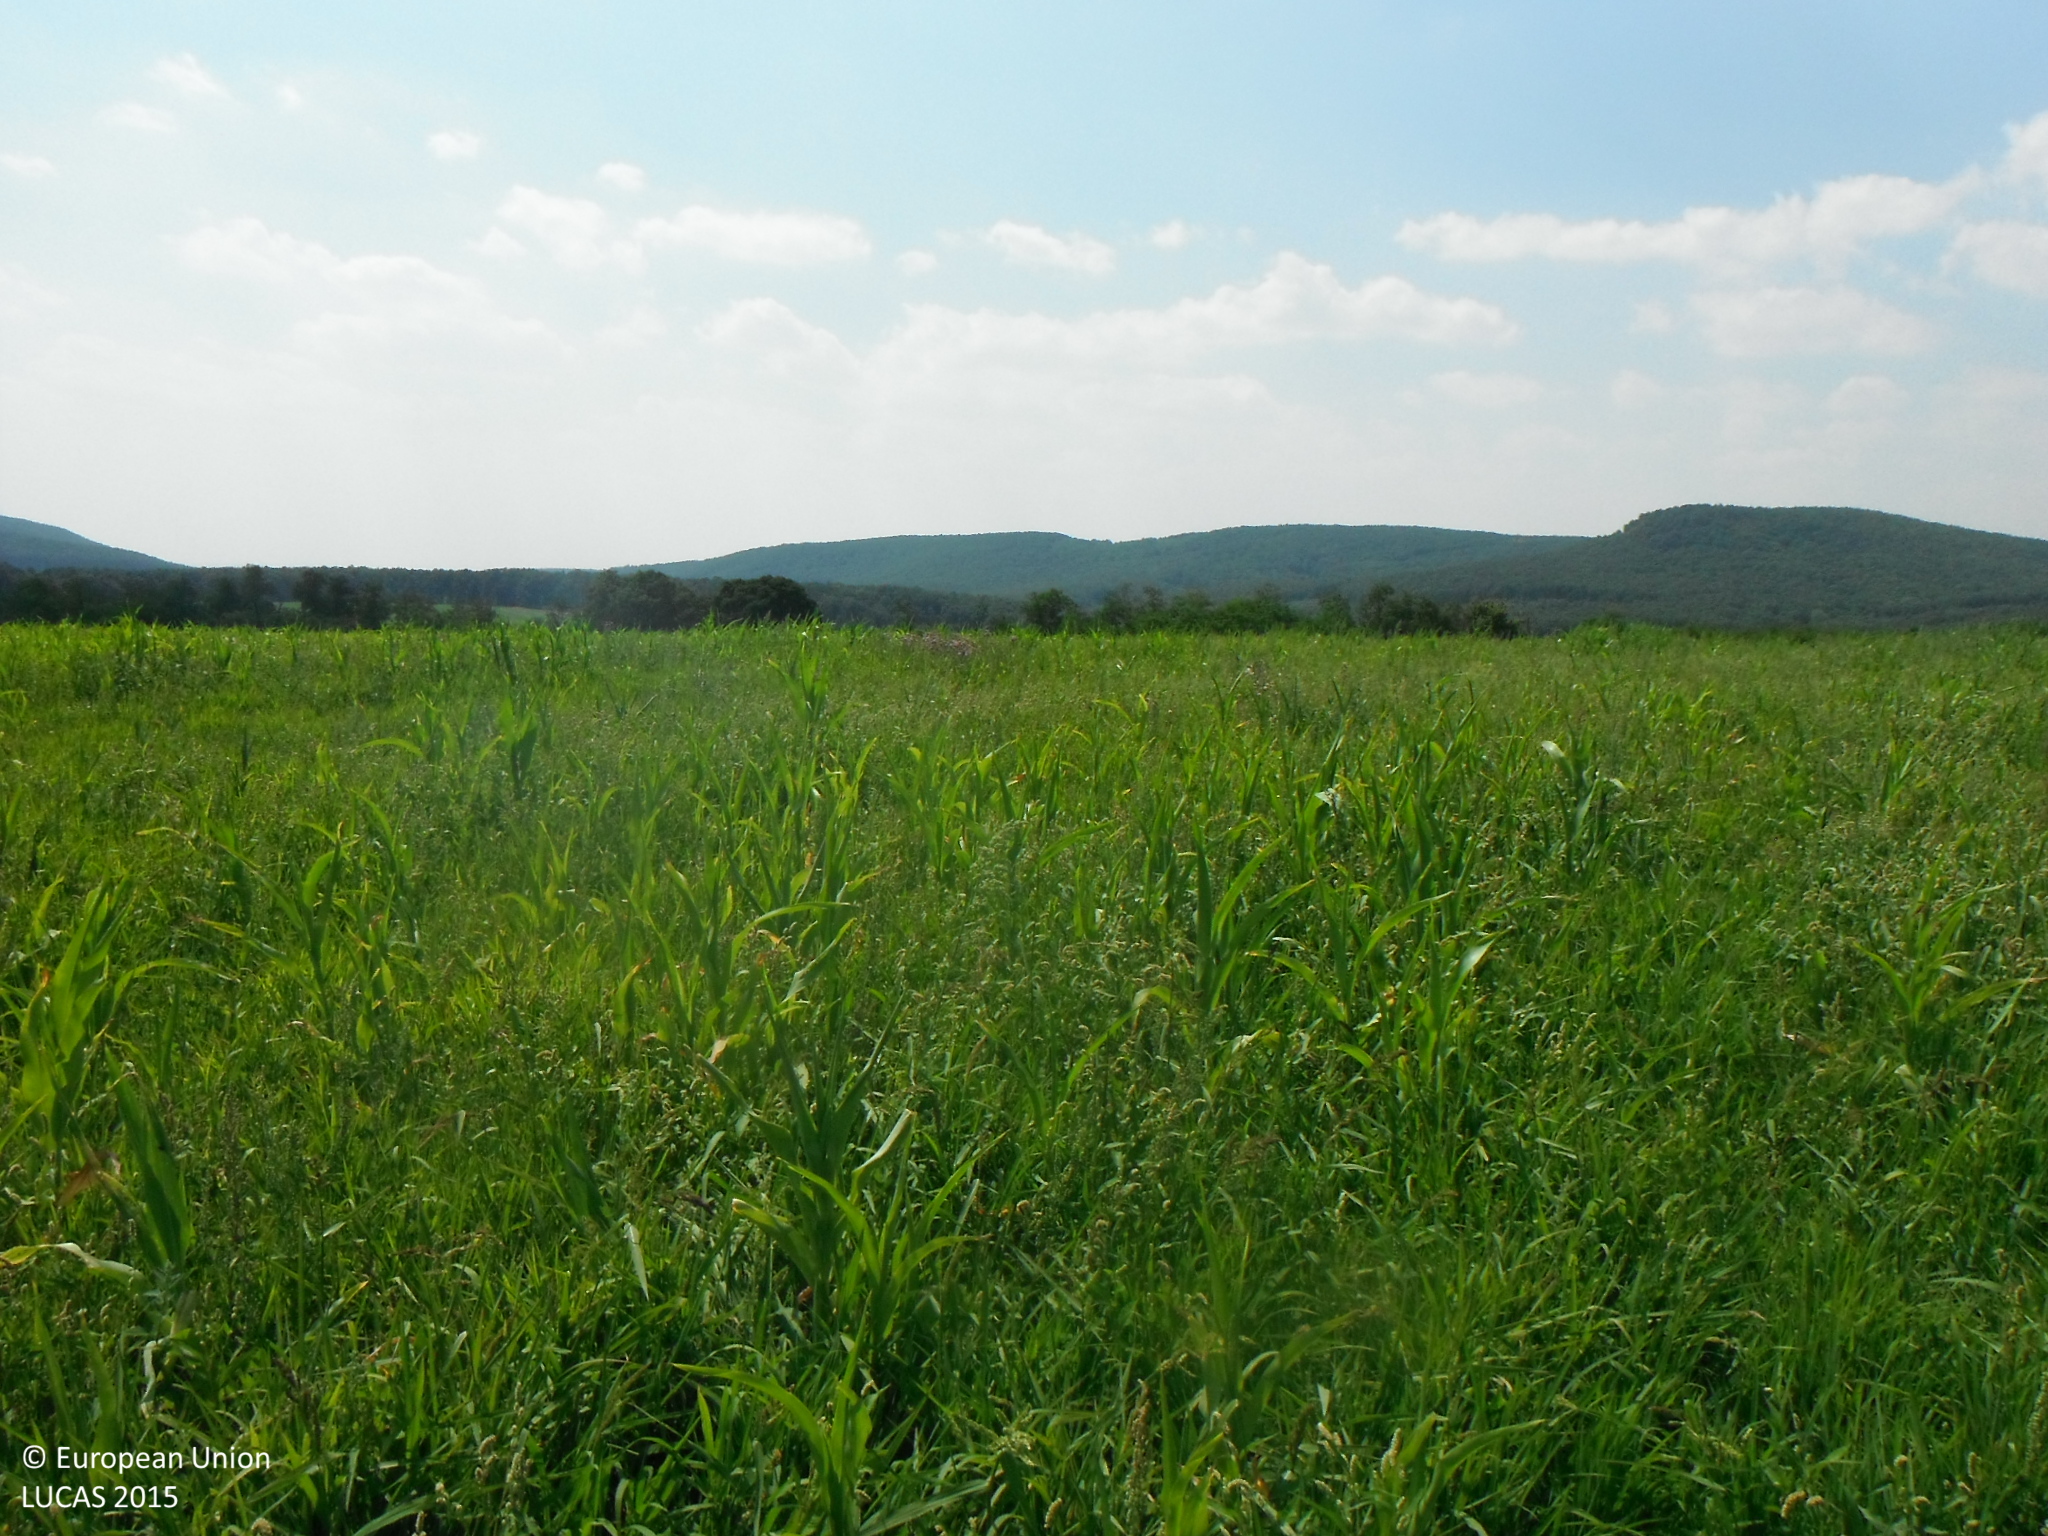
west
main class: Cropland
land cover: Maize
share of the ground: 25 - 50 %
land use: Agriculture (excluding fallow land and kitchen gardens)
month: July
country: SK
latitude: 48.1035
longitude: 19.0579
